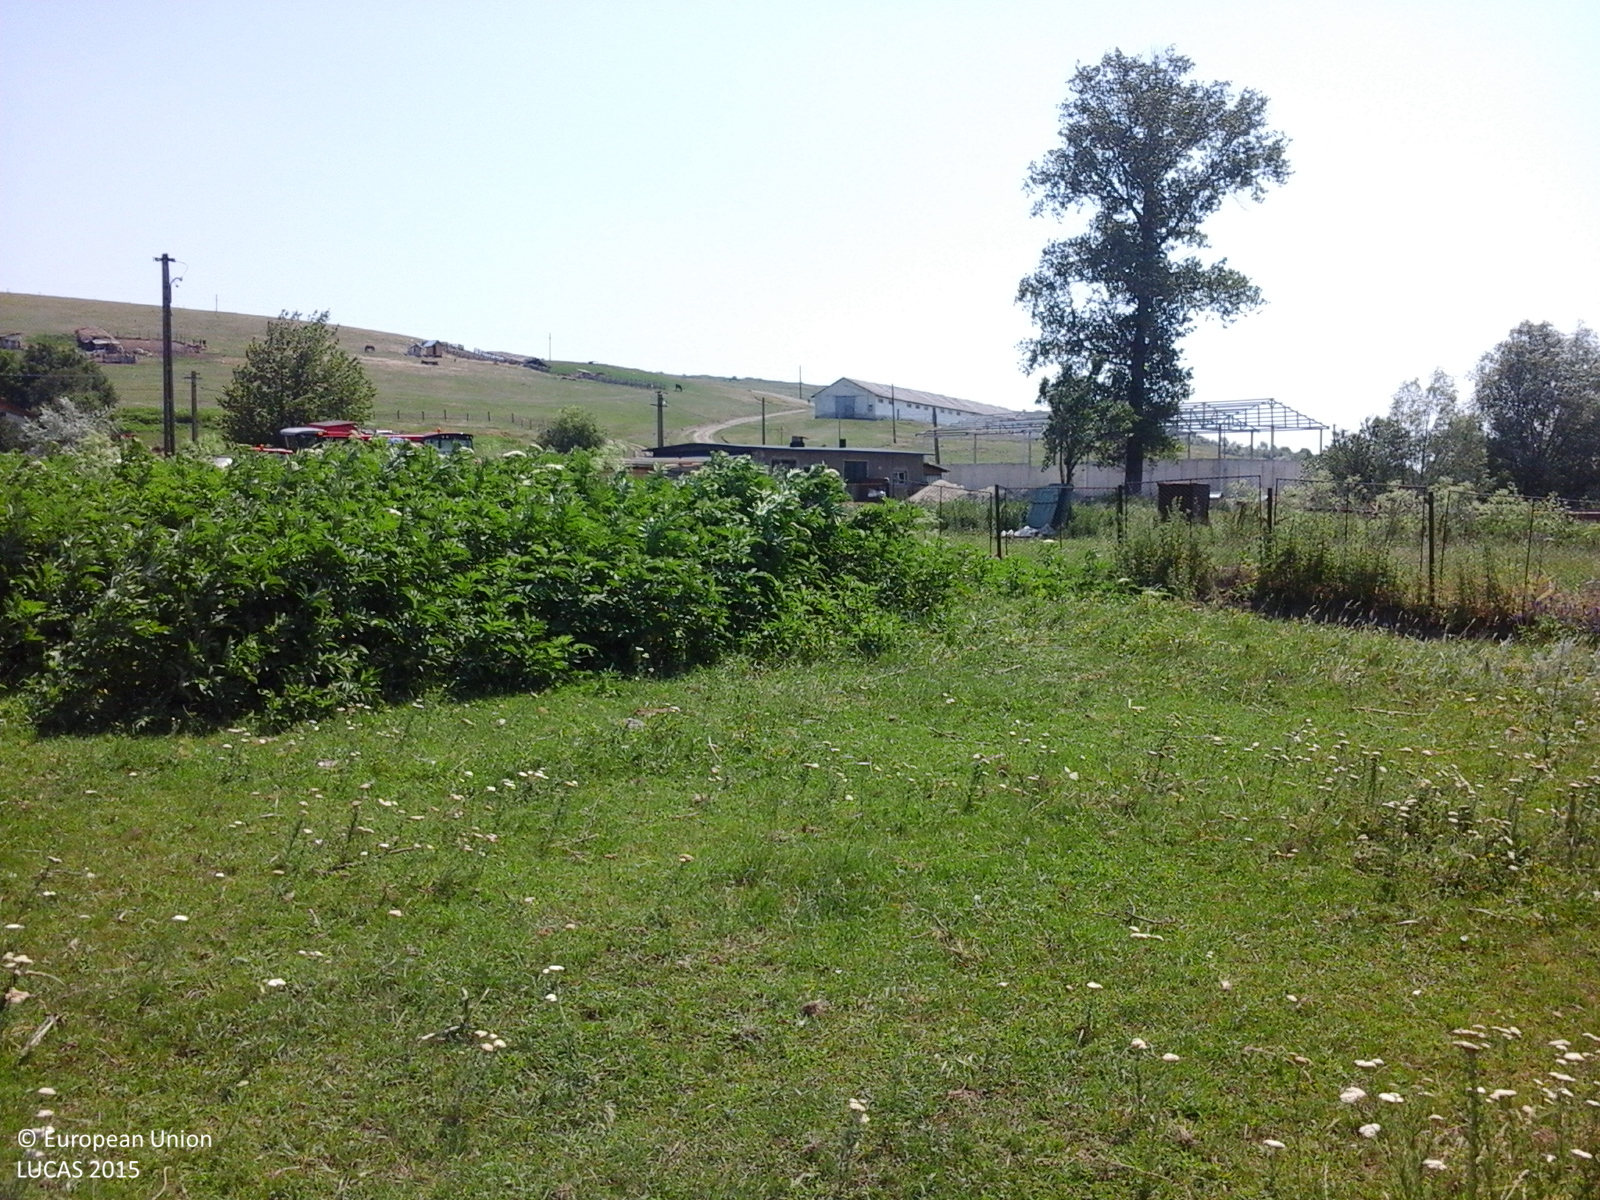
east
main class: Grassland
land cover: Grassland without tree/shrub cover
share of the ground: > 75 %
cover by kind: herbaceous plants 100 %
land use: Agriculture (excluding fallow land and kitchen gardens)
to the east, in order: Grassland without tree/shrub cover; Ditches and canals; Fences; Grassland without tree/shrub cover; Artificial constructions in urban areas; Ditches and canals; Paved roads, cycling and walking lanes; Ditches and canals; Fences; Spontaneously vegetated surfaces; Electric lines; Spontaneously vegetated surfaces; Fences; Grassland without tree/shrub cover; Tracks; Grassland without tree/shrub cover
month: June
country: RO
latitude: 46.7345
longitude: 27.5047
